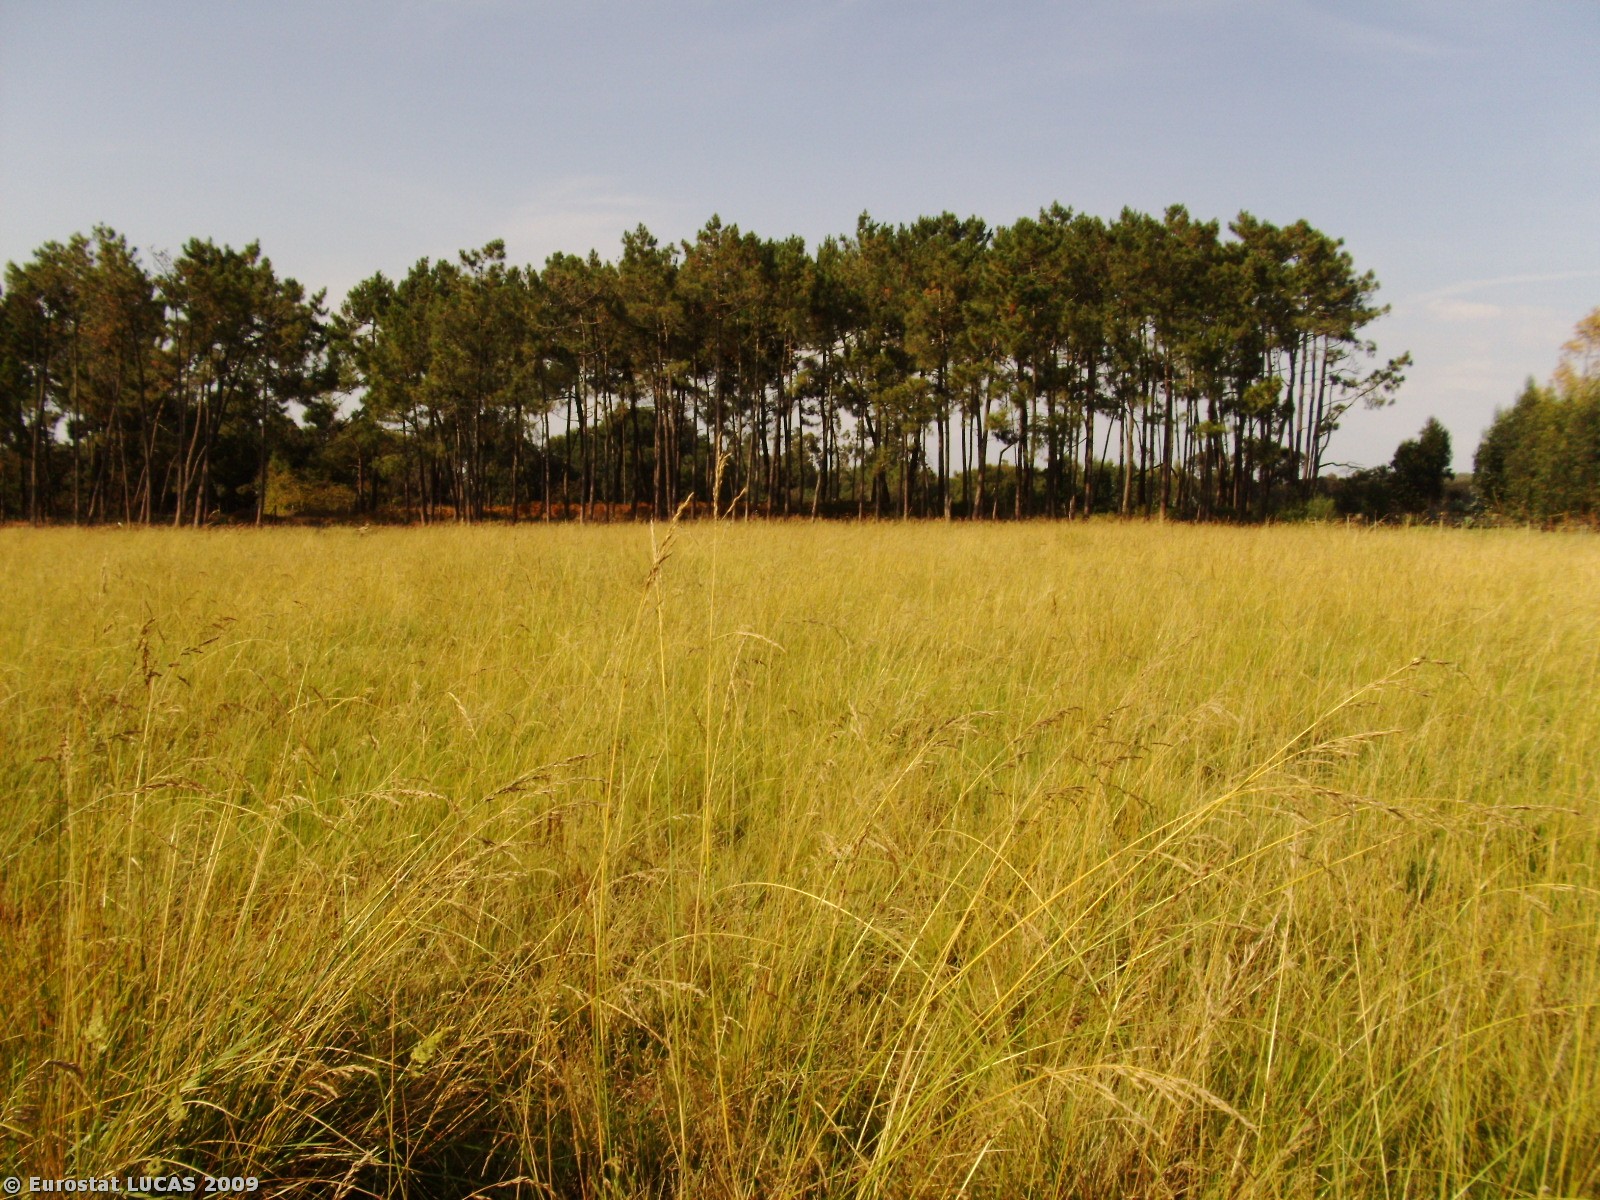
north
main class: Cropland
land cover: Temporary grasslands
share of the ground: > 75 %
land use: Agriculture (excluding fallow land and kitchen gardens)
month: June
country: PT
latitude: 37.4772
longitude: -8.7533
